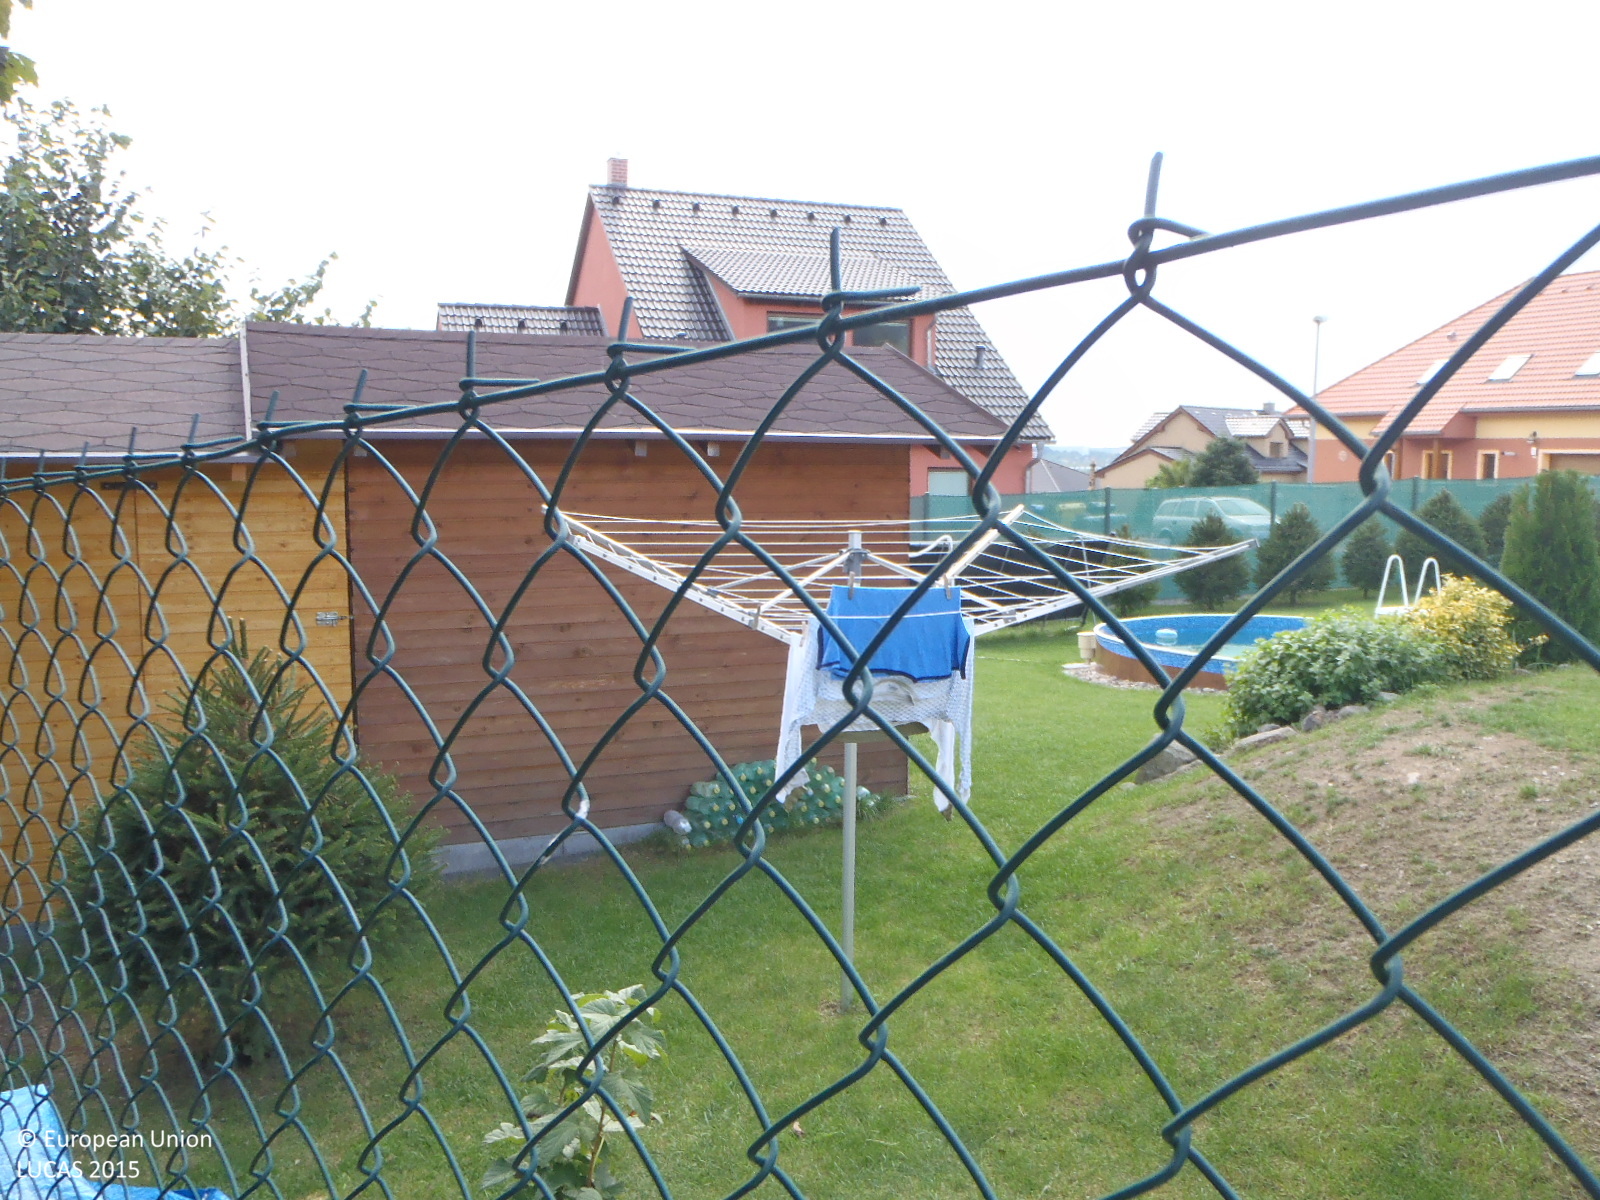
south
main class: Woodland
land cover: Broadleaved woodland
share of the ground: > 75 %
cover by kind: broadleaved forest trees 90 %, shrubs 10 %
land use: Semi-natural and natural areas not in use
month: September
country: CZ
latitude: 50.6769
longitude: 13.8642
